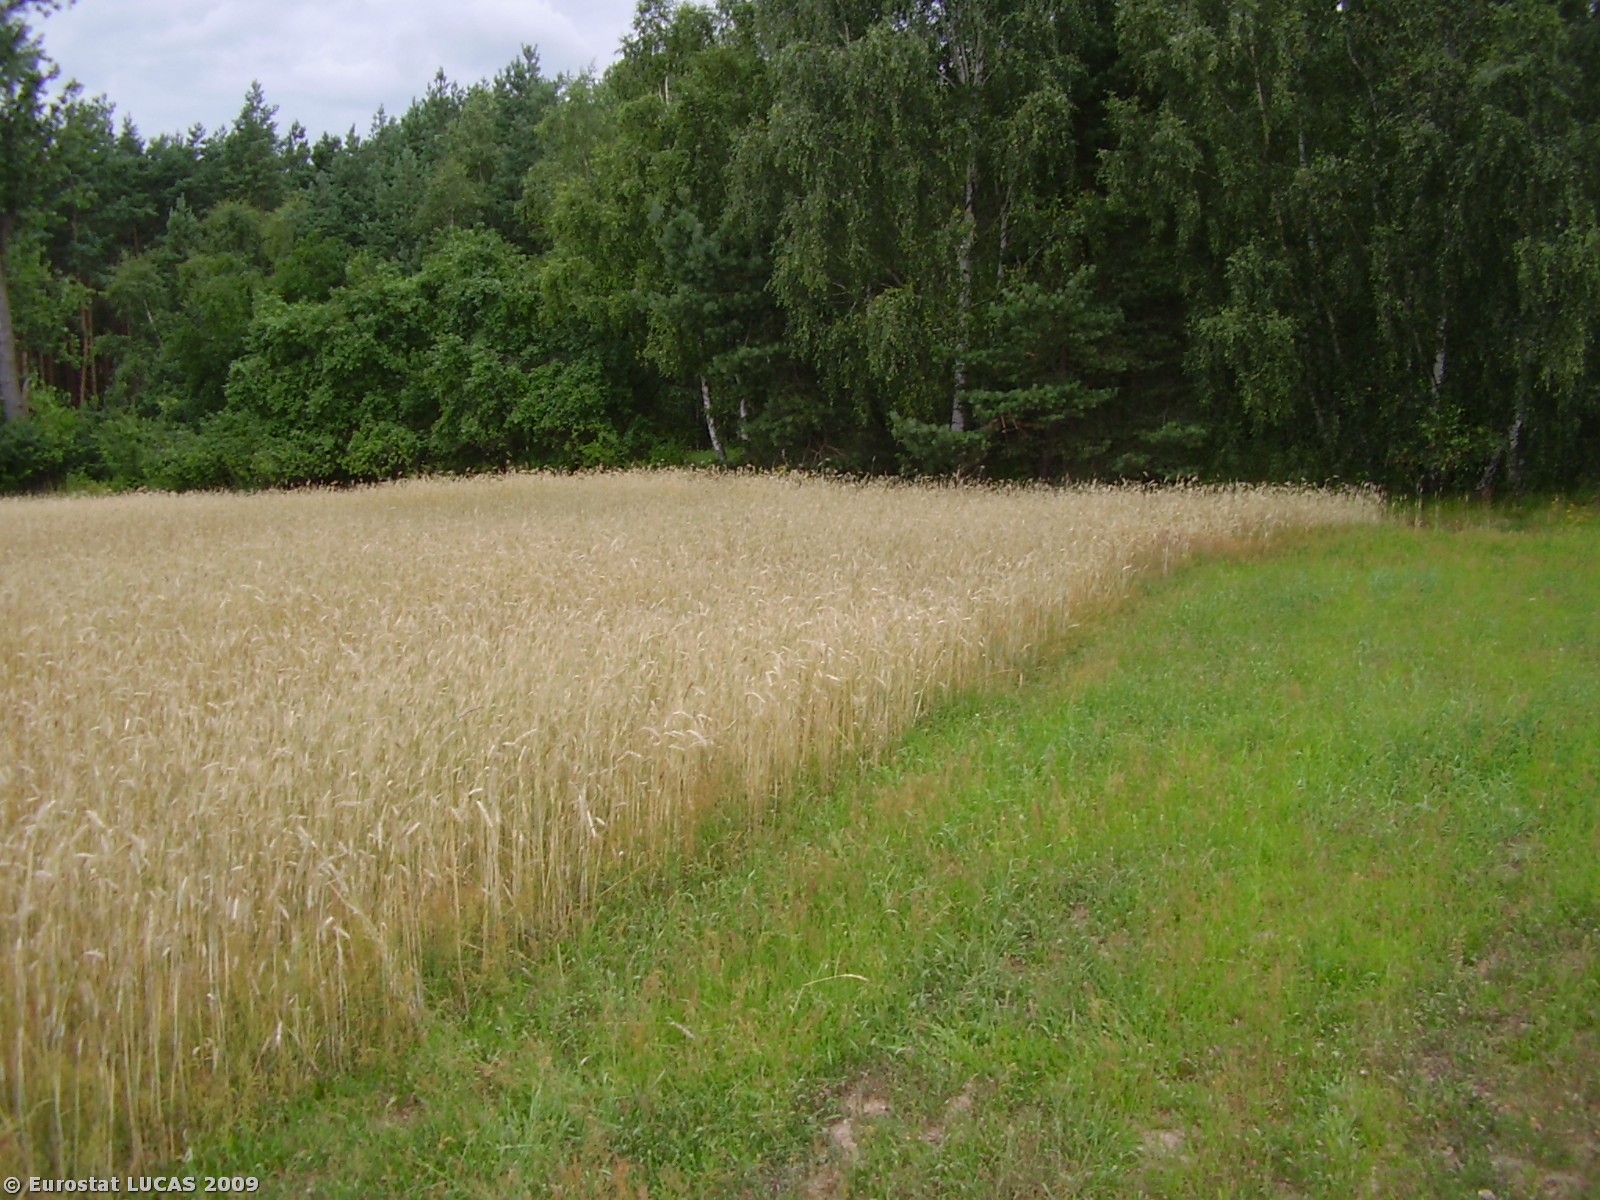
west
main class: Grassland
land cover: Grassland without tree/shrub cover
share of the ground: > 75 %
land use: Fallow land
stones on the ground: 25 - 50 %
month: July
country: PL
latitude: 51.8694
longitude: 16.2664
